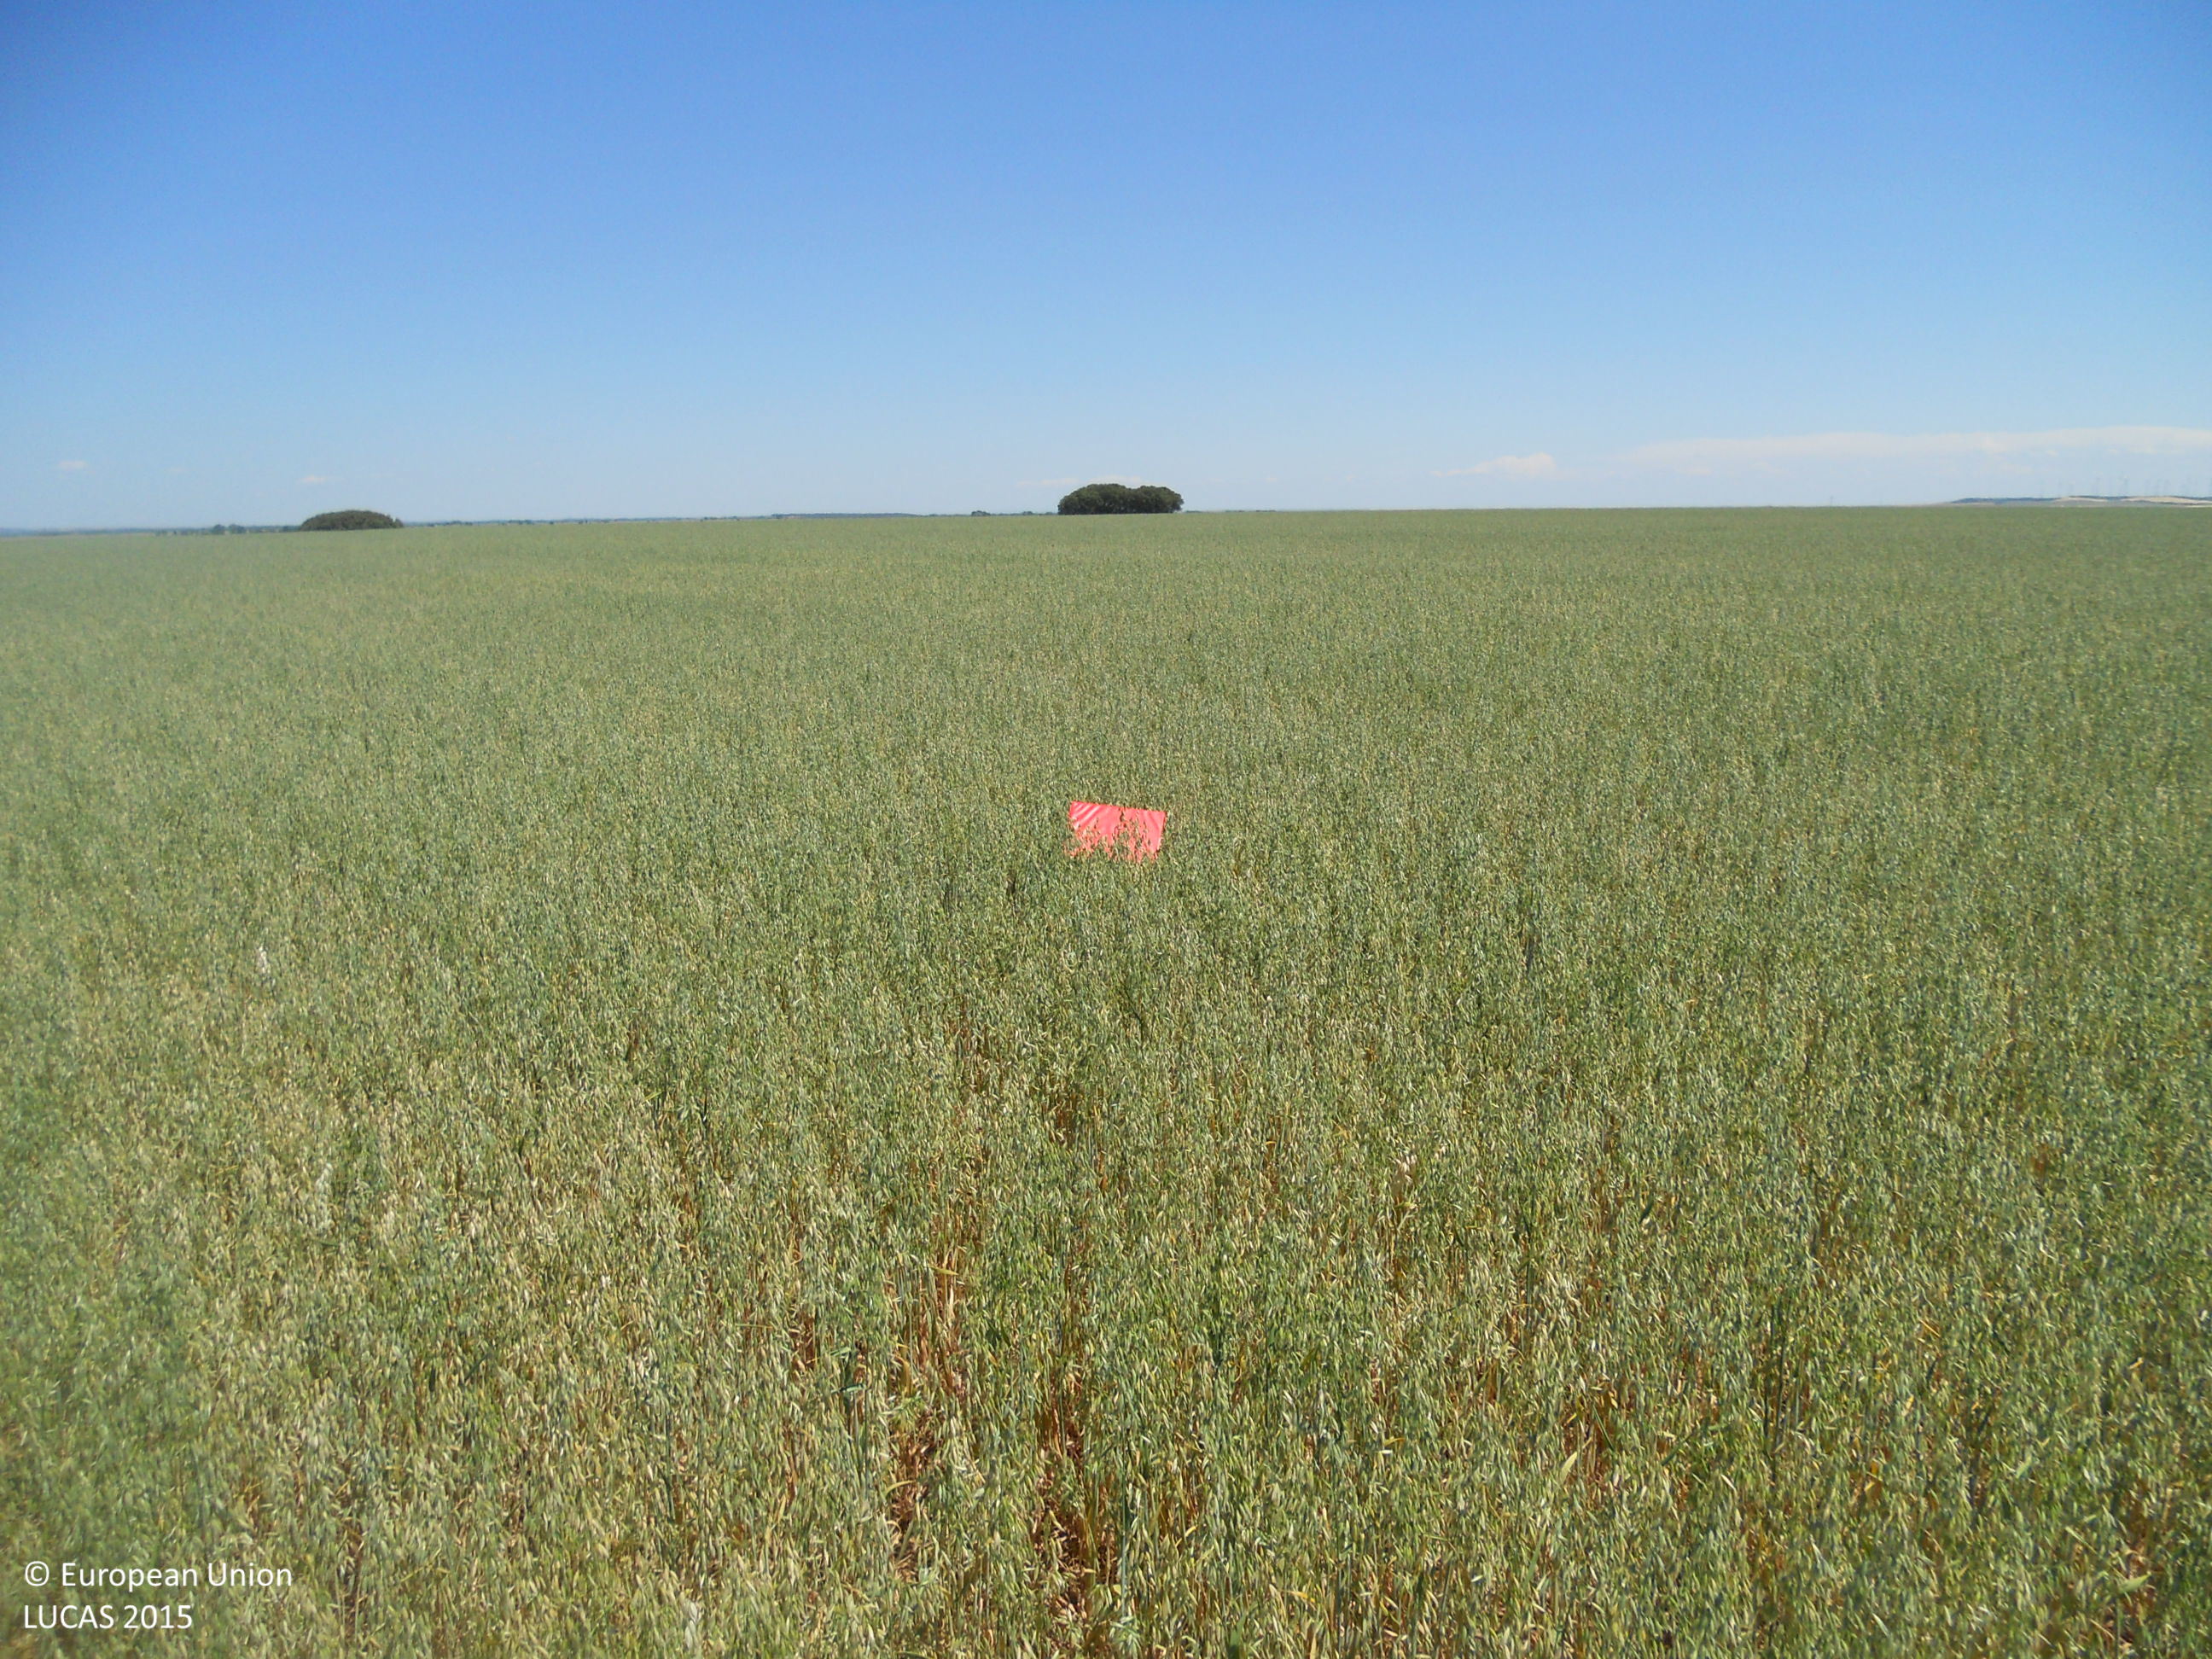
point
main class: Cropland
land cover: Oats
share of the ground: > 75 %
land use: Agriculture (excluding fallow land and kitchen gardens)
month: May
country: ES
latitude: 42.3086
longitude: -4.8187
